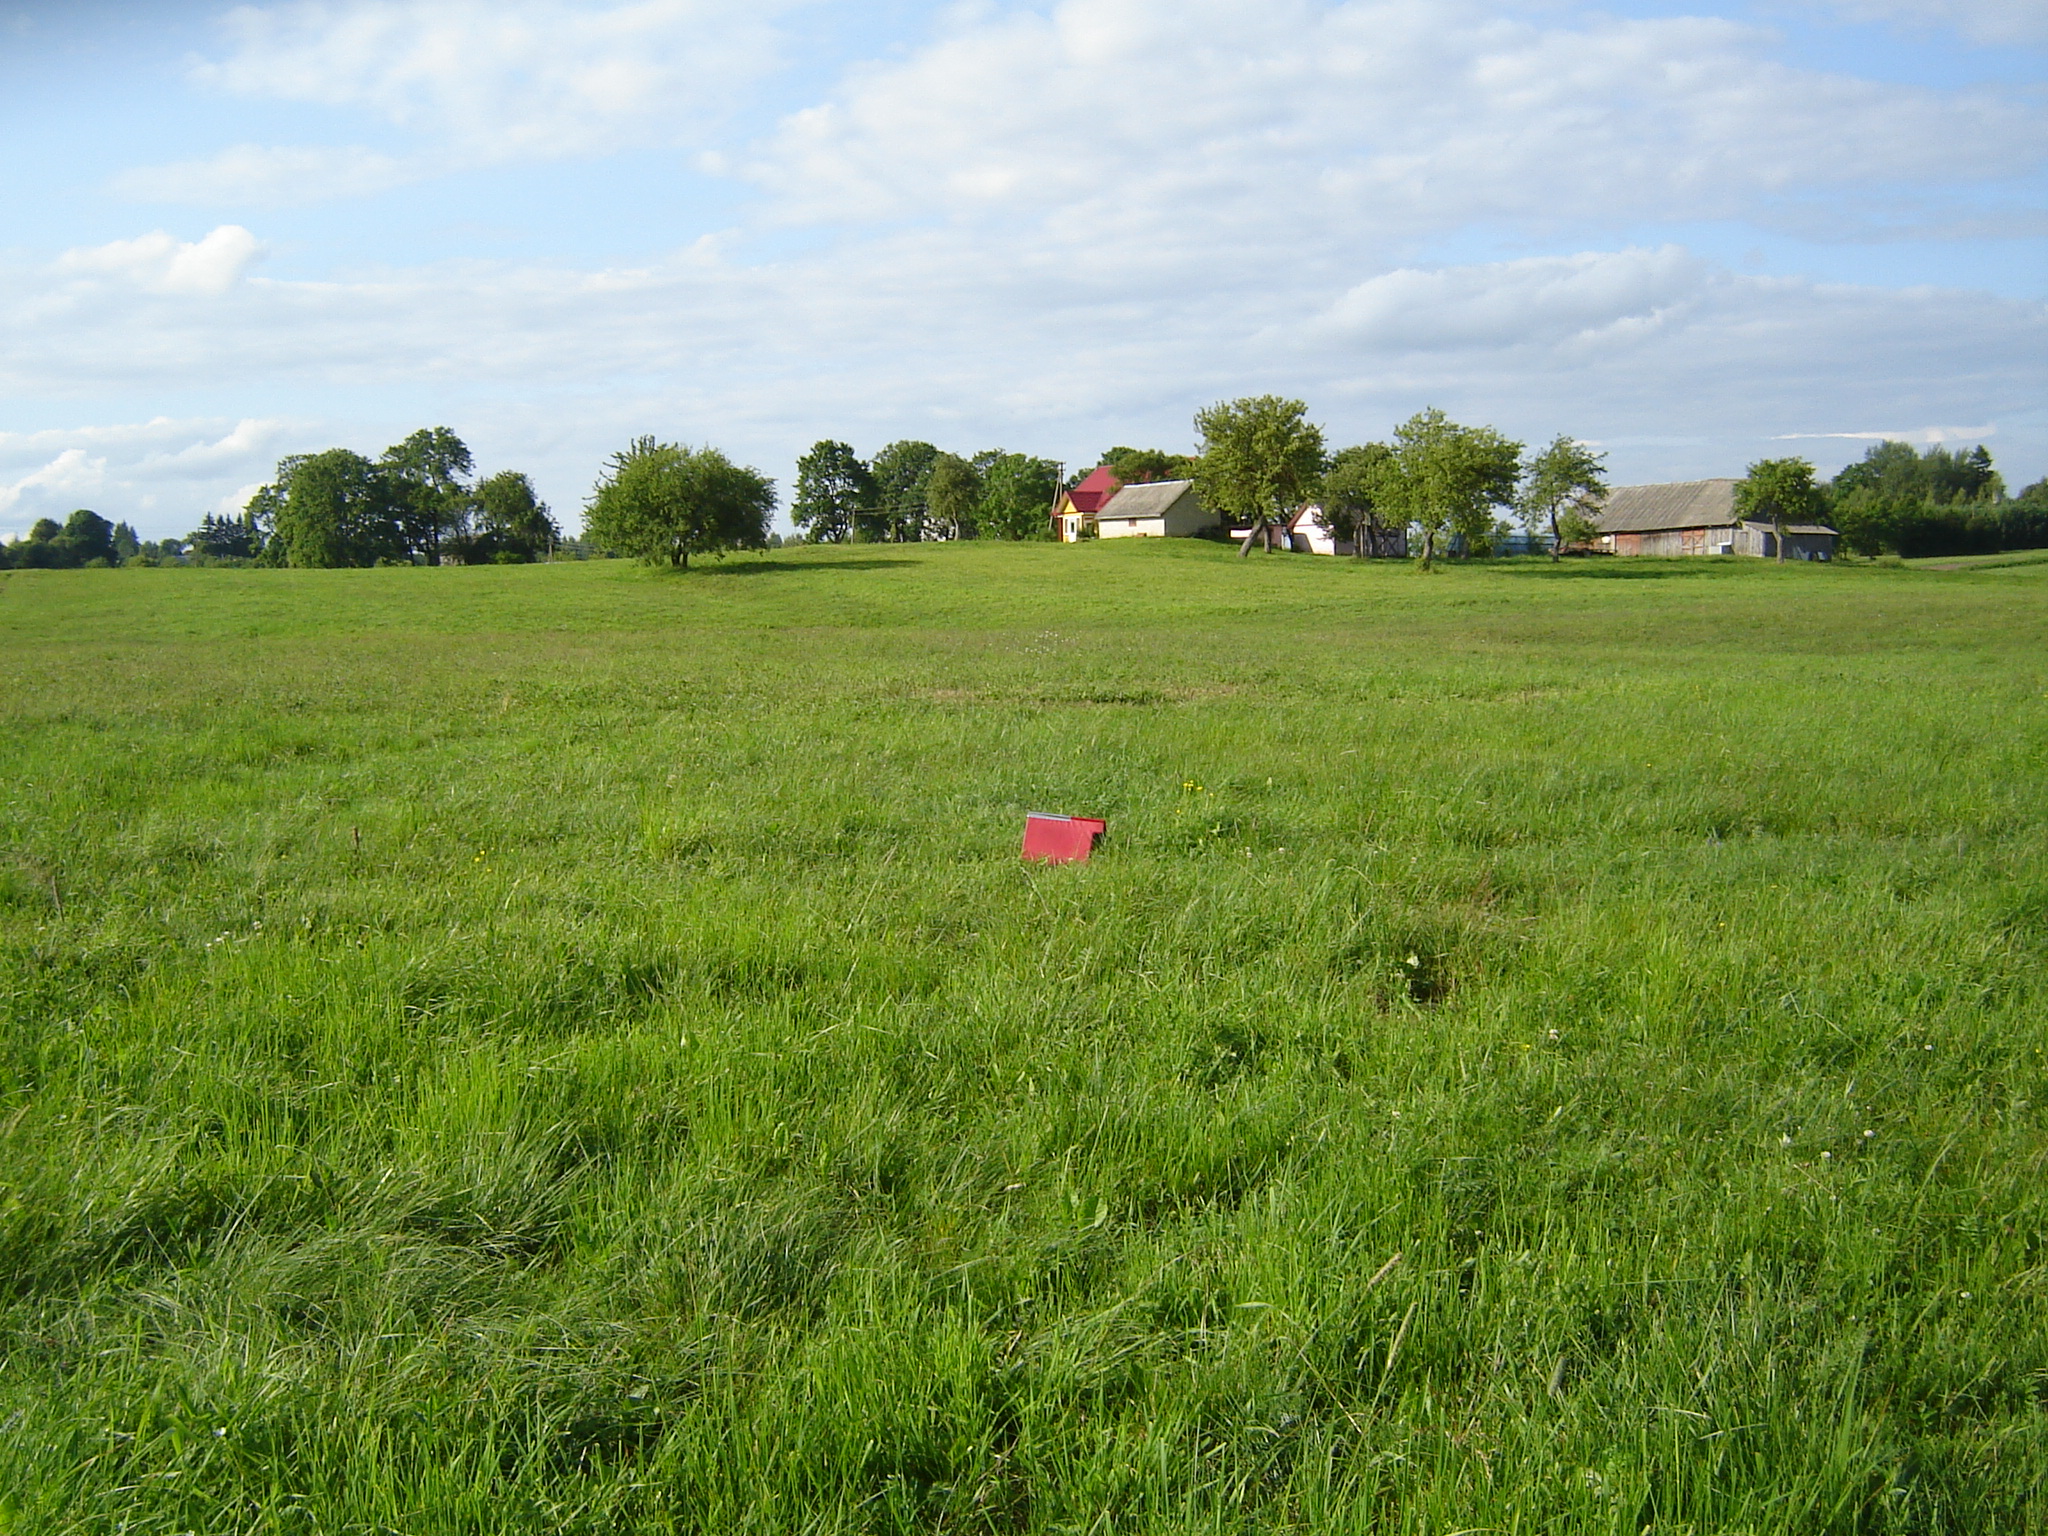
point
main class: Grassland
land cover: Grassland without tree/shrub cover
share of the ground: > 75 %
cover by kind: herbaceous plants 100 %
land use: Agriculture (excluding fallow land and kitchen gardens)
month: July
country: LT
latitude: 55.3125
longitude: 25.4866
